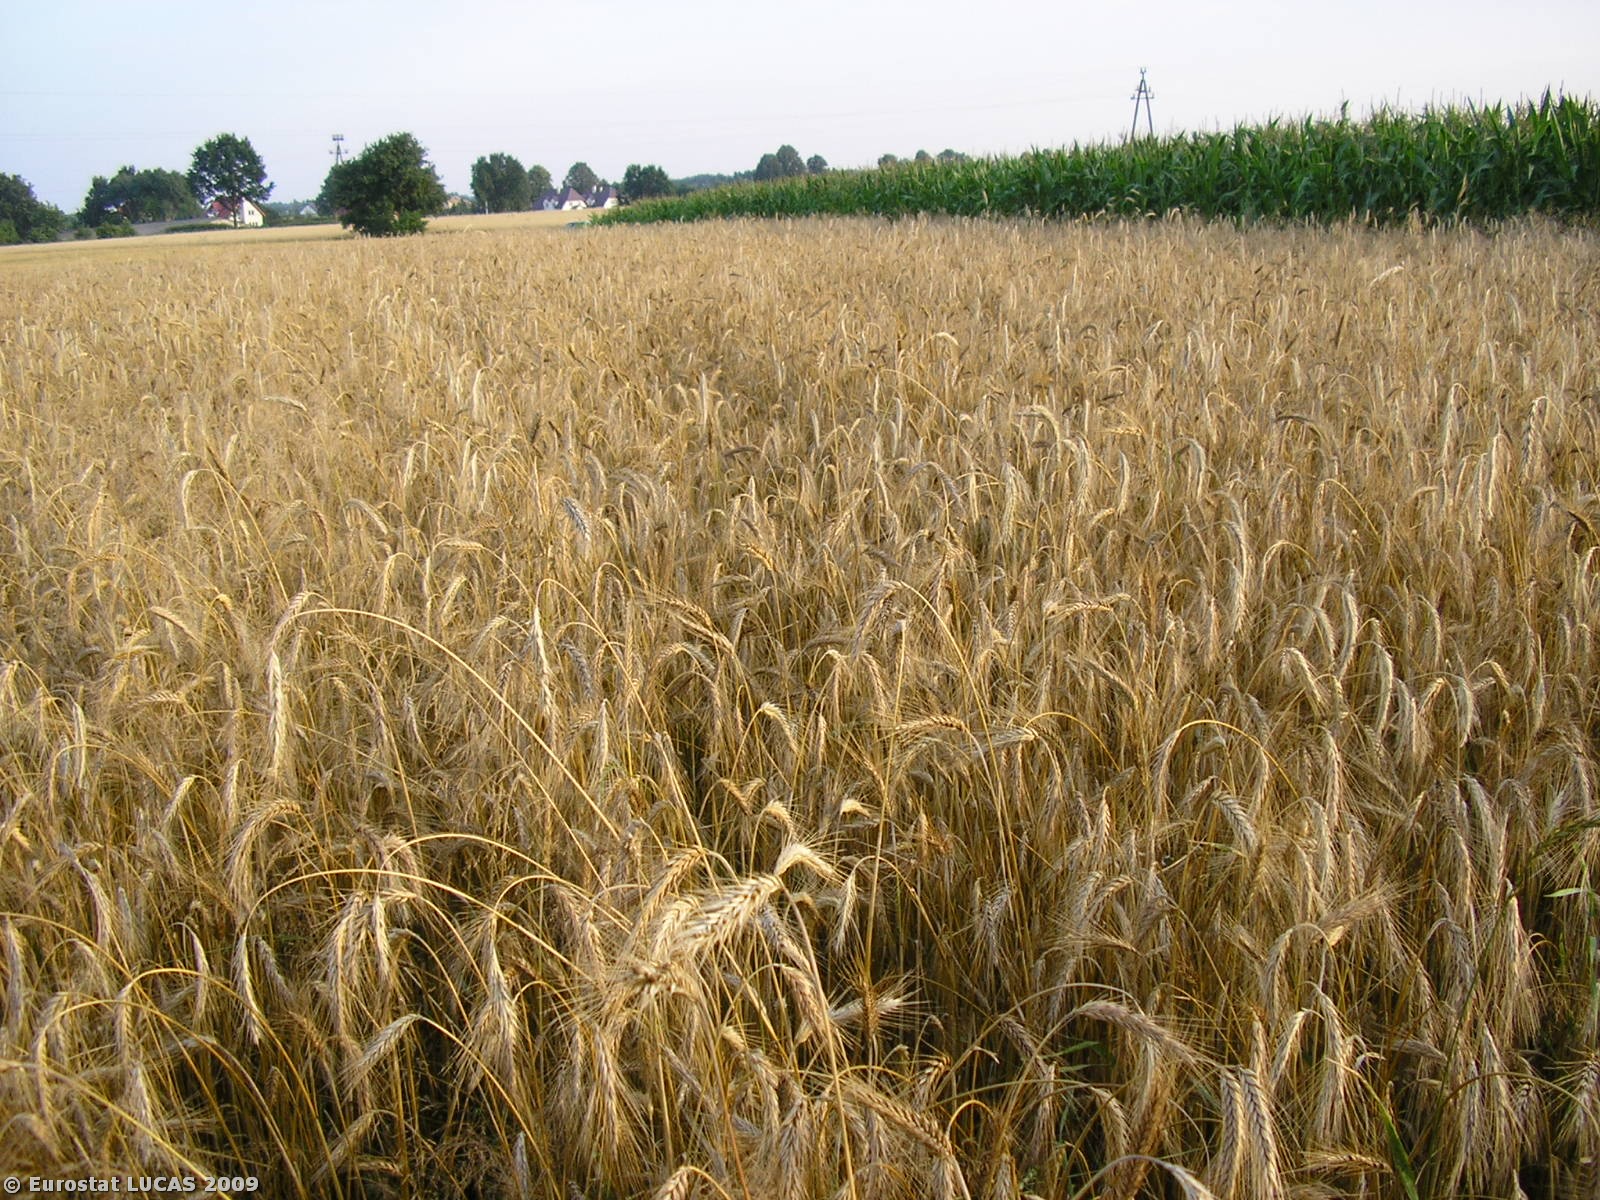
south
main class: Cropland
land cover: Rye
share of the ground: > 75 %
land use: Agriculture (excluding fallow land and kitchen gardens)
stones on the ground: < 10 %
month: July
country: PL
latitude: 52.1303
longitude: 22.1714
